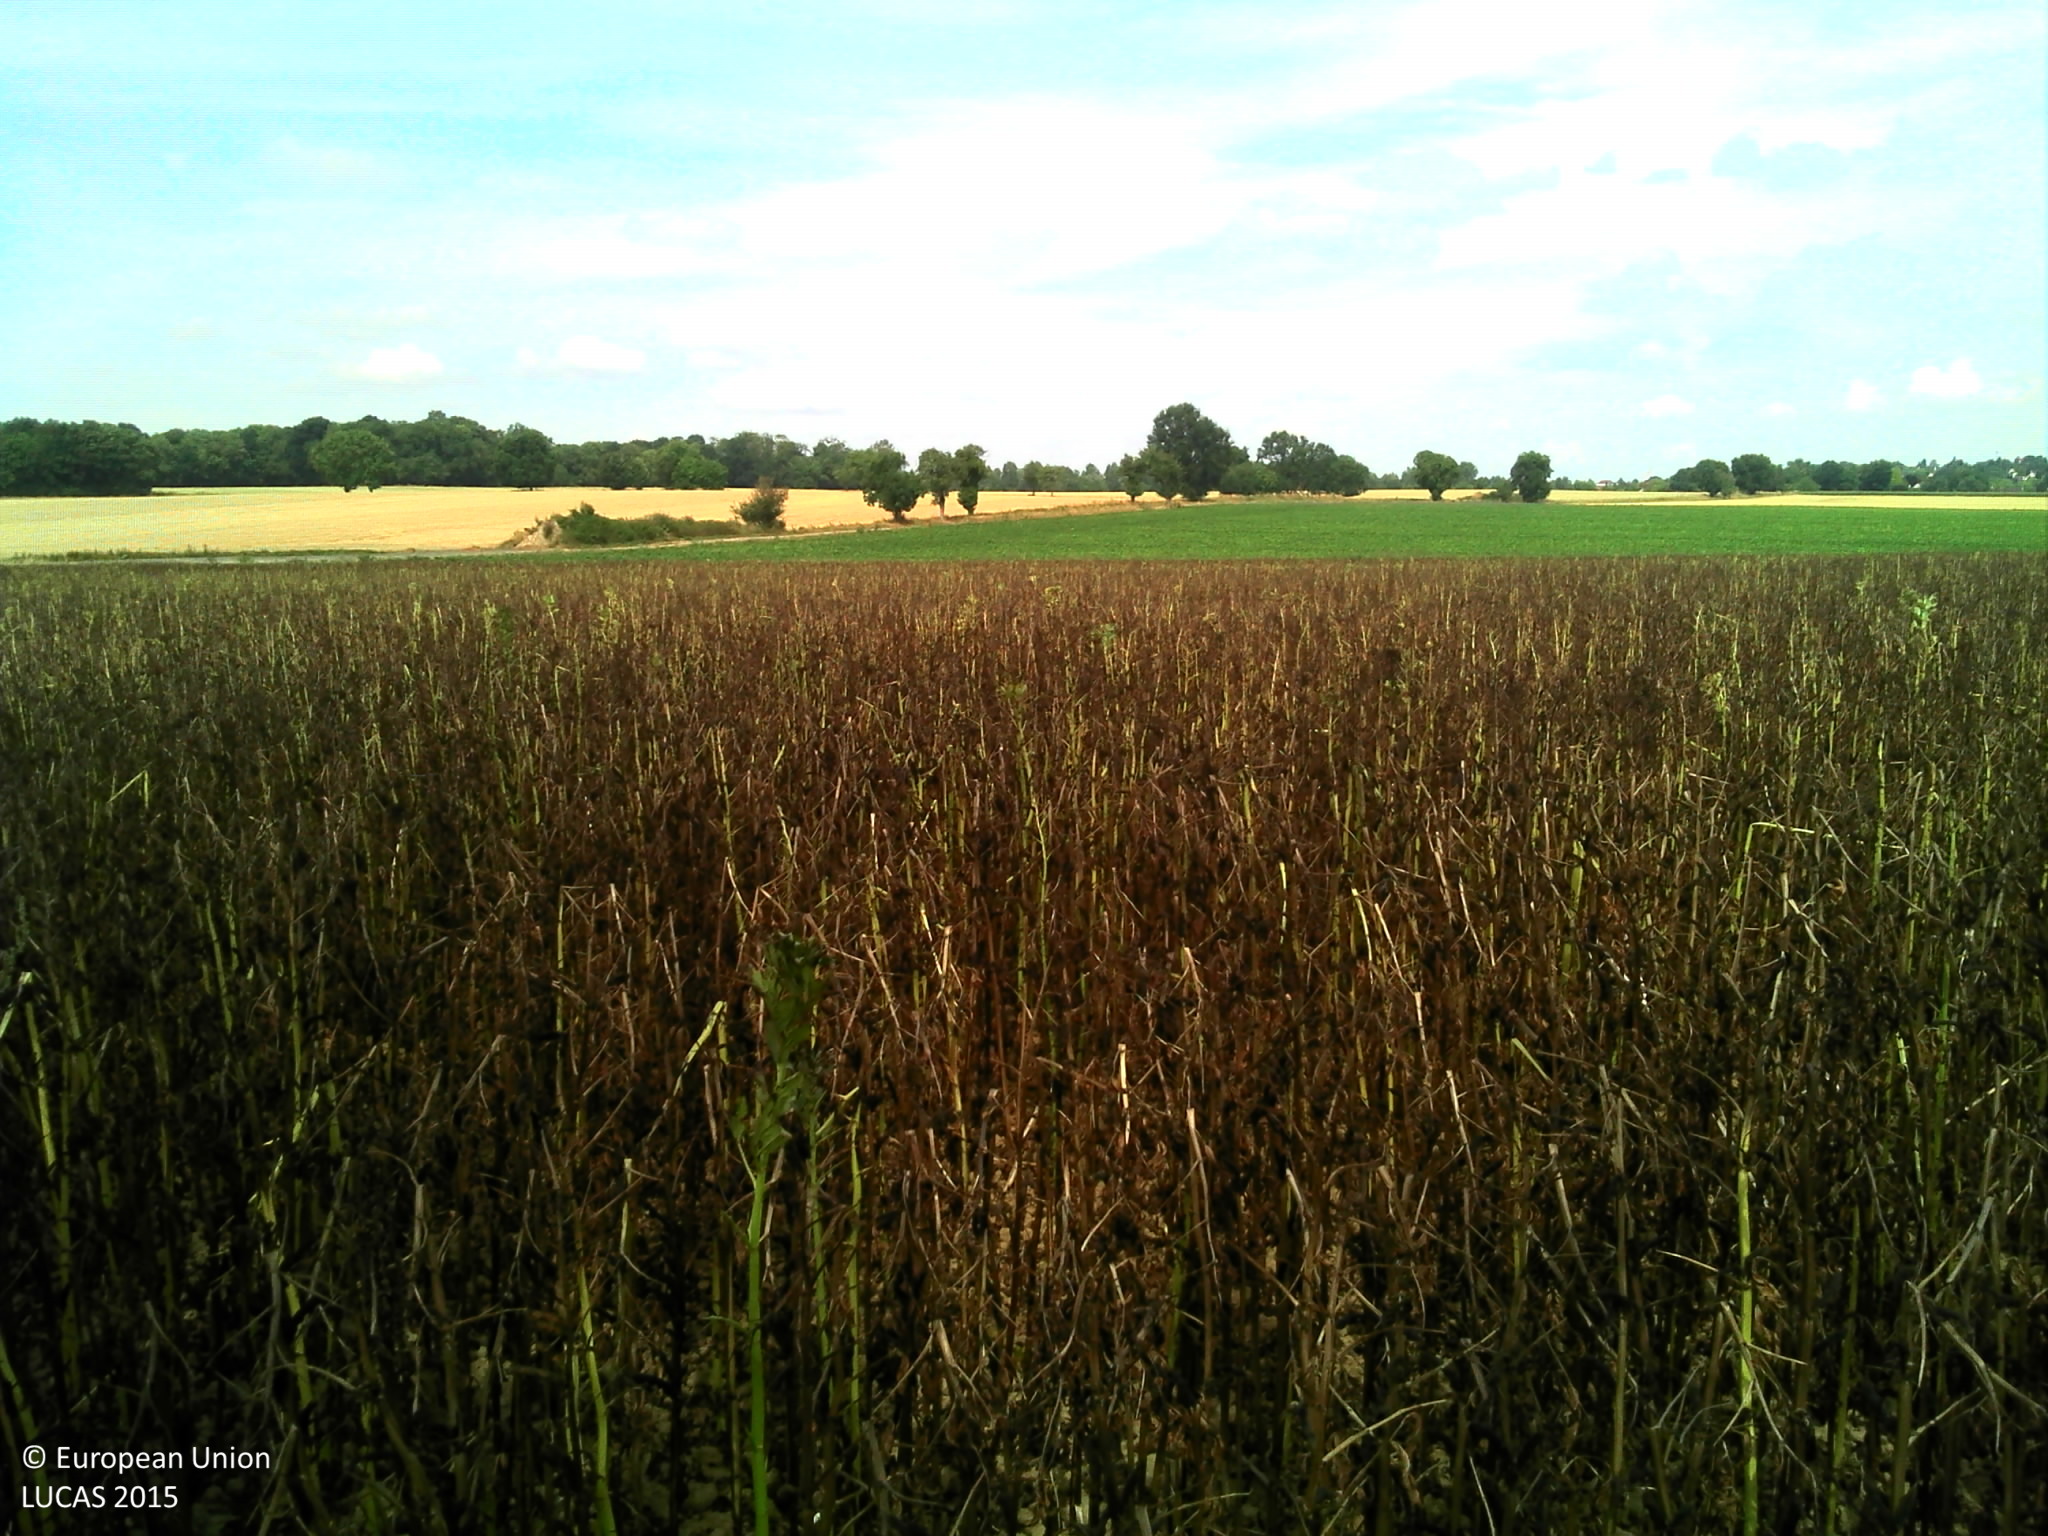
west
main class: Cropland
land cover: Other non-permanent industrial crops
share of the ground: > 75 %
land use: Agriculture (excluding fallow land and kitchen gardens)
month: July
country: FR
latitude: 49.0756
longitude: 2.5828
